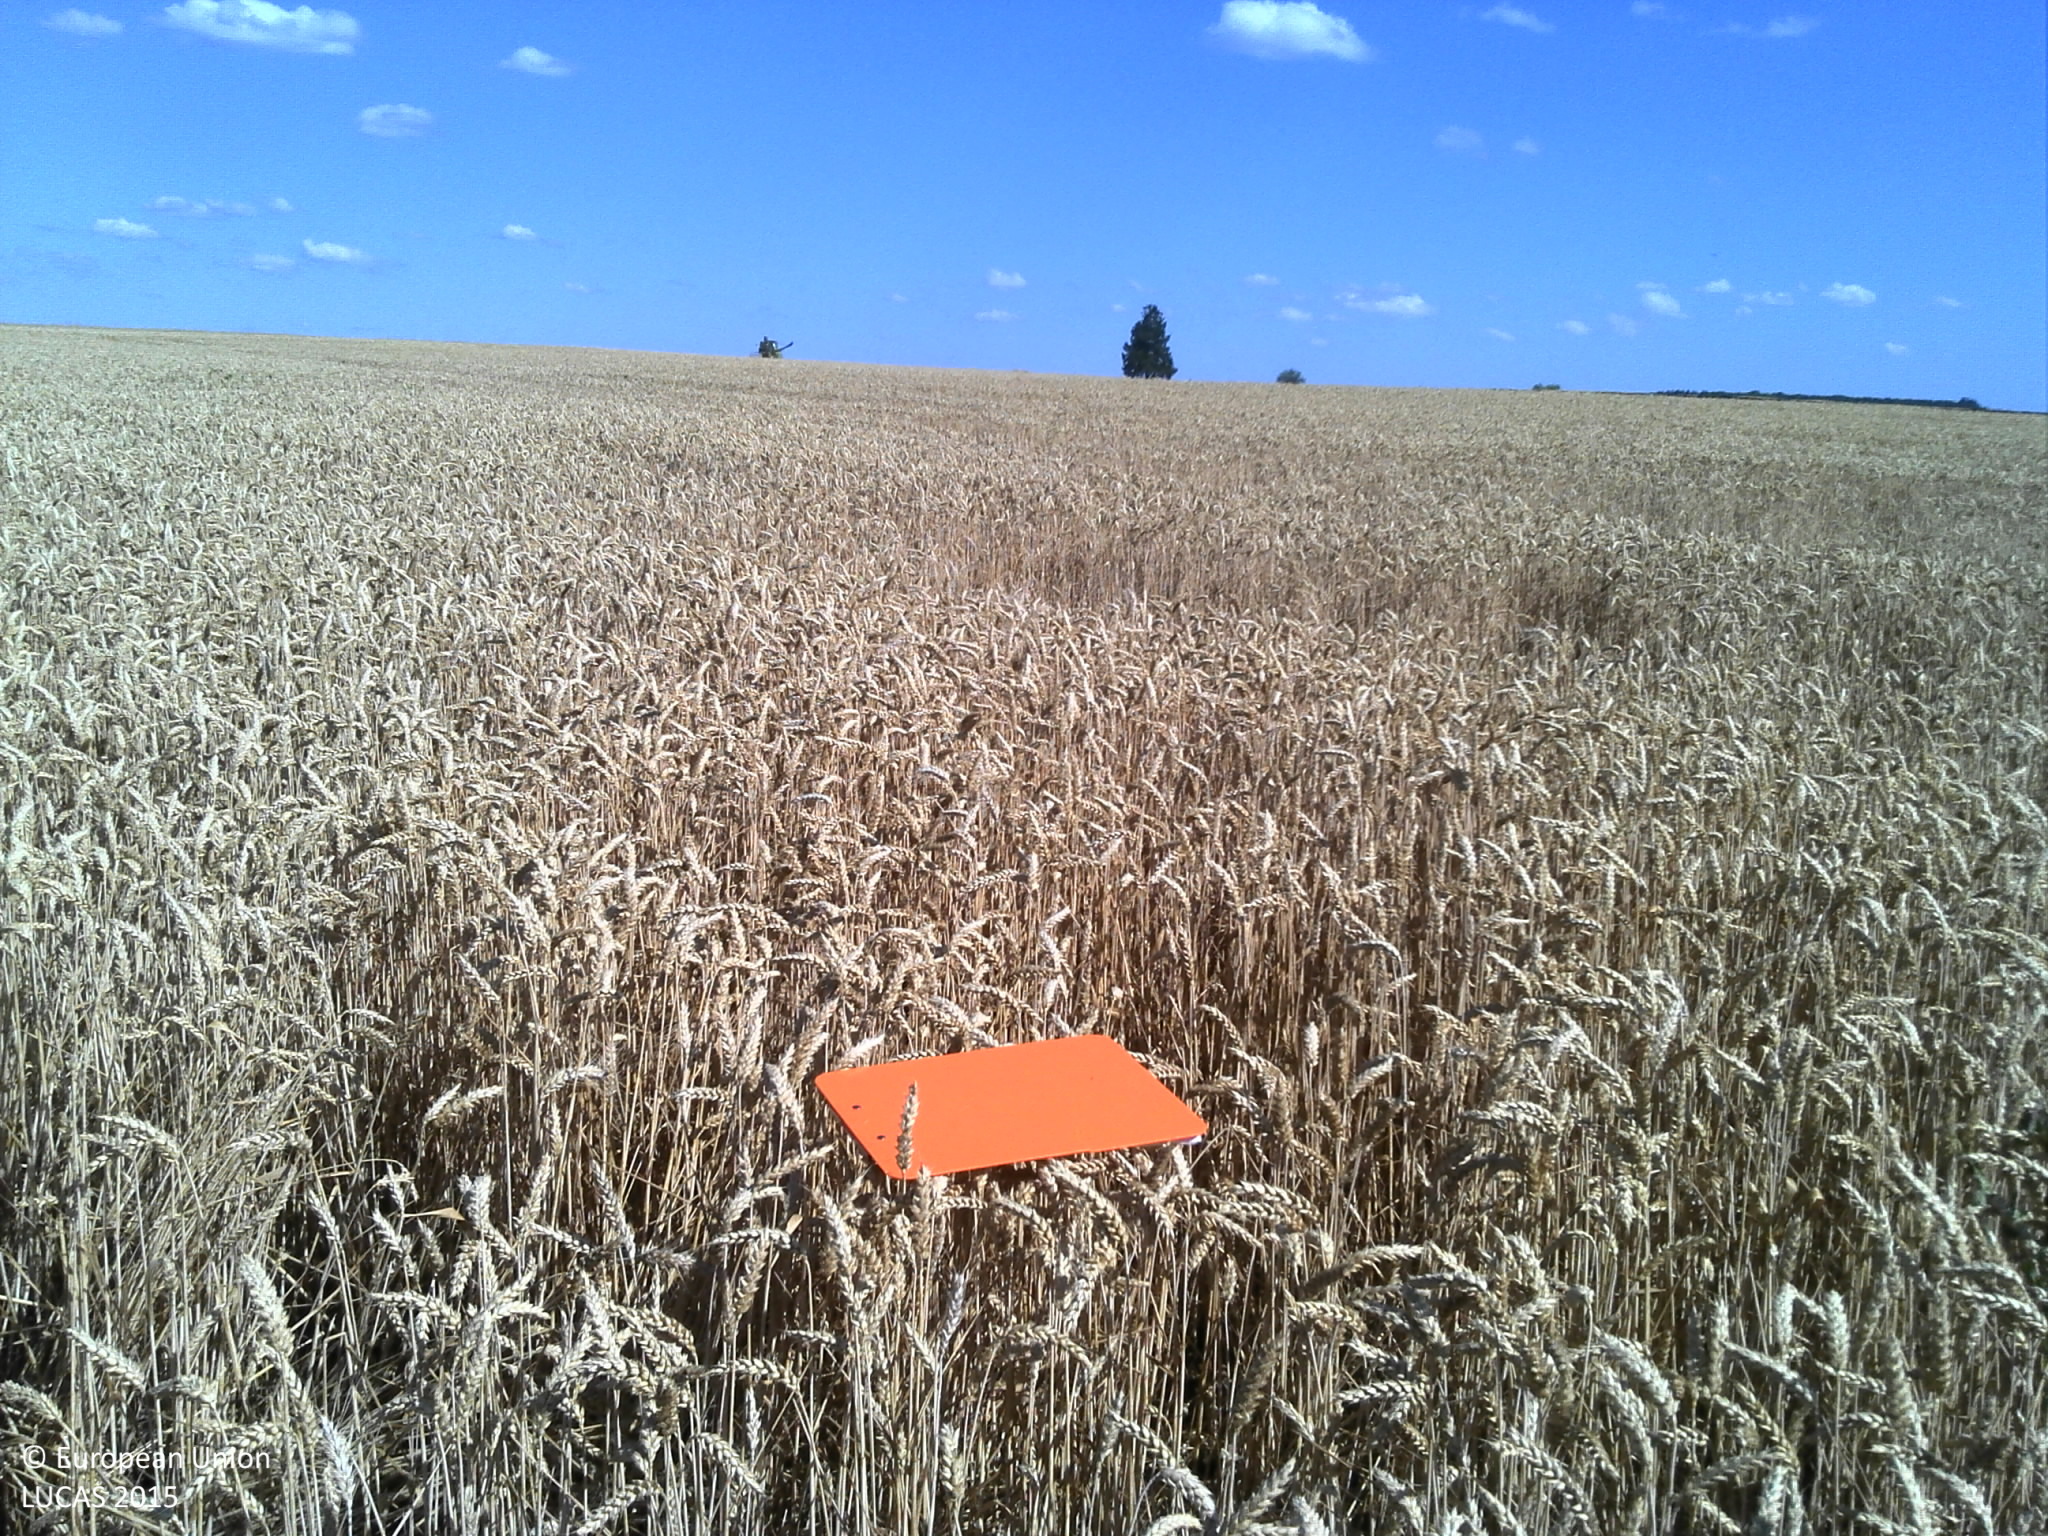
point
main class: Cropland
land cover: Common wheat
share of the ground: > 75 %
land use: Agriculture (excluding fallow land and kitchen gardens)
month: July
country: FR
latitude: 49.0361
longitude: 7.2785
